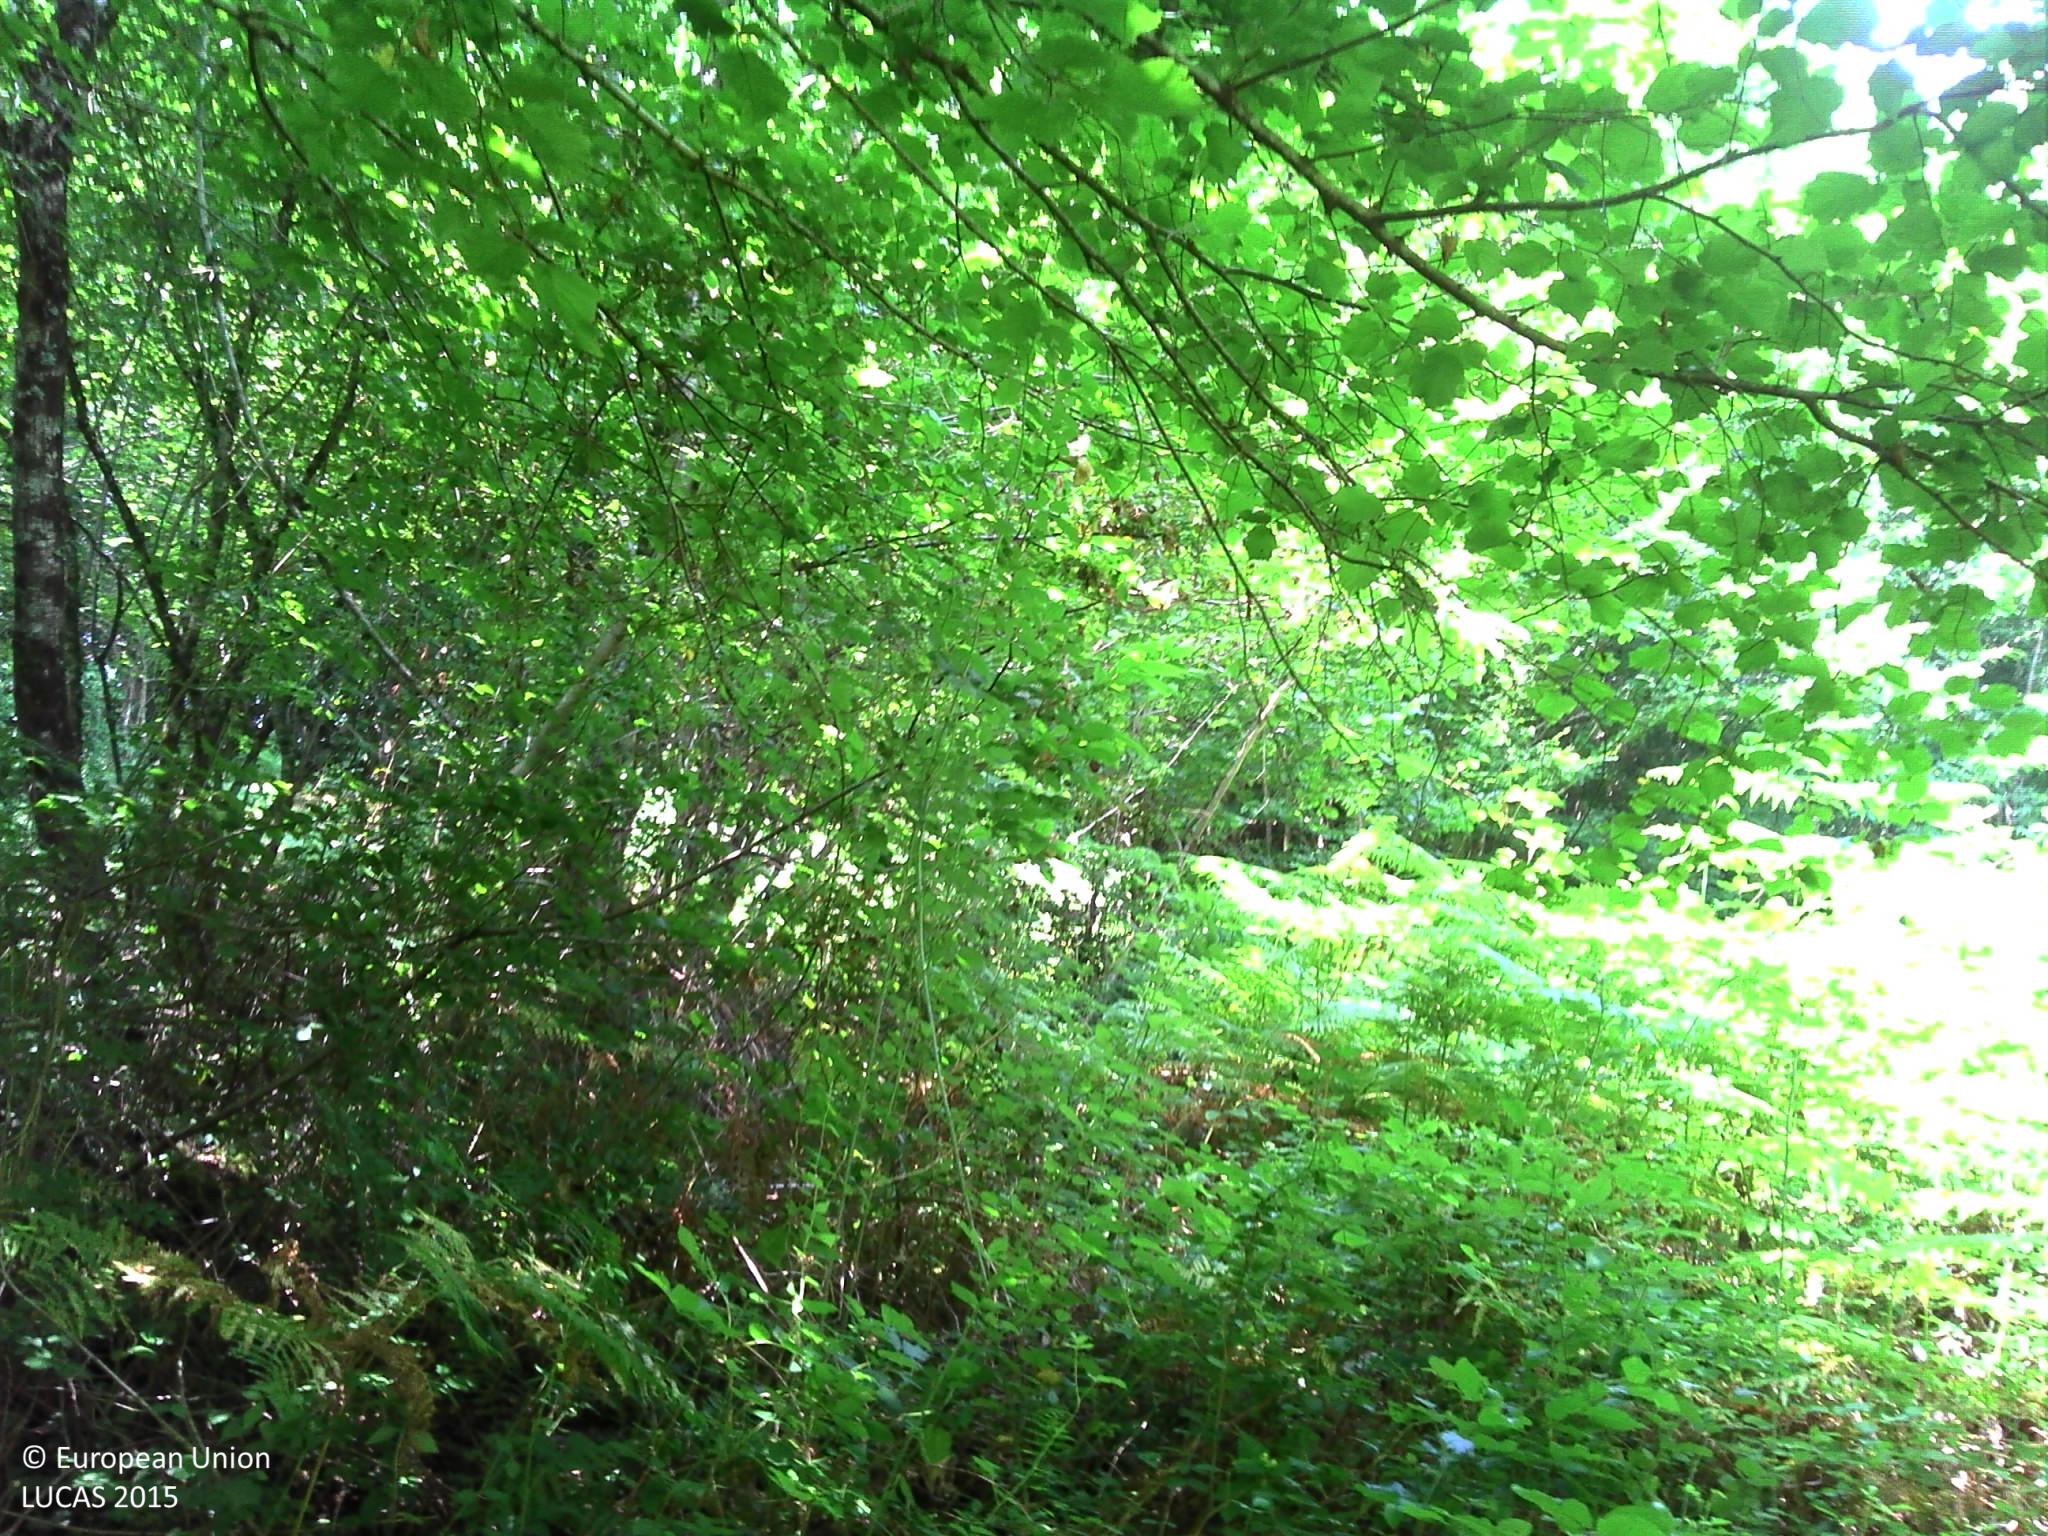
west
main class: Woodland
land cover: Broadleaved woodland
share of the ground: > 75 %
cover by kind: broadleaved forest trees 50 %, shrubs 40 %, herbaceous plants 10 %
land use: Agriculture (excluding fallow land and kitchen gardens)
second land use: Forestry
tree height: > 5 m
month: July
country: FR
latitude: 43.0541
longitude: 1.0289
